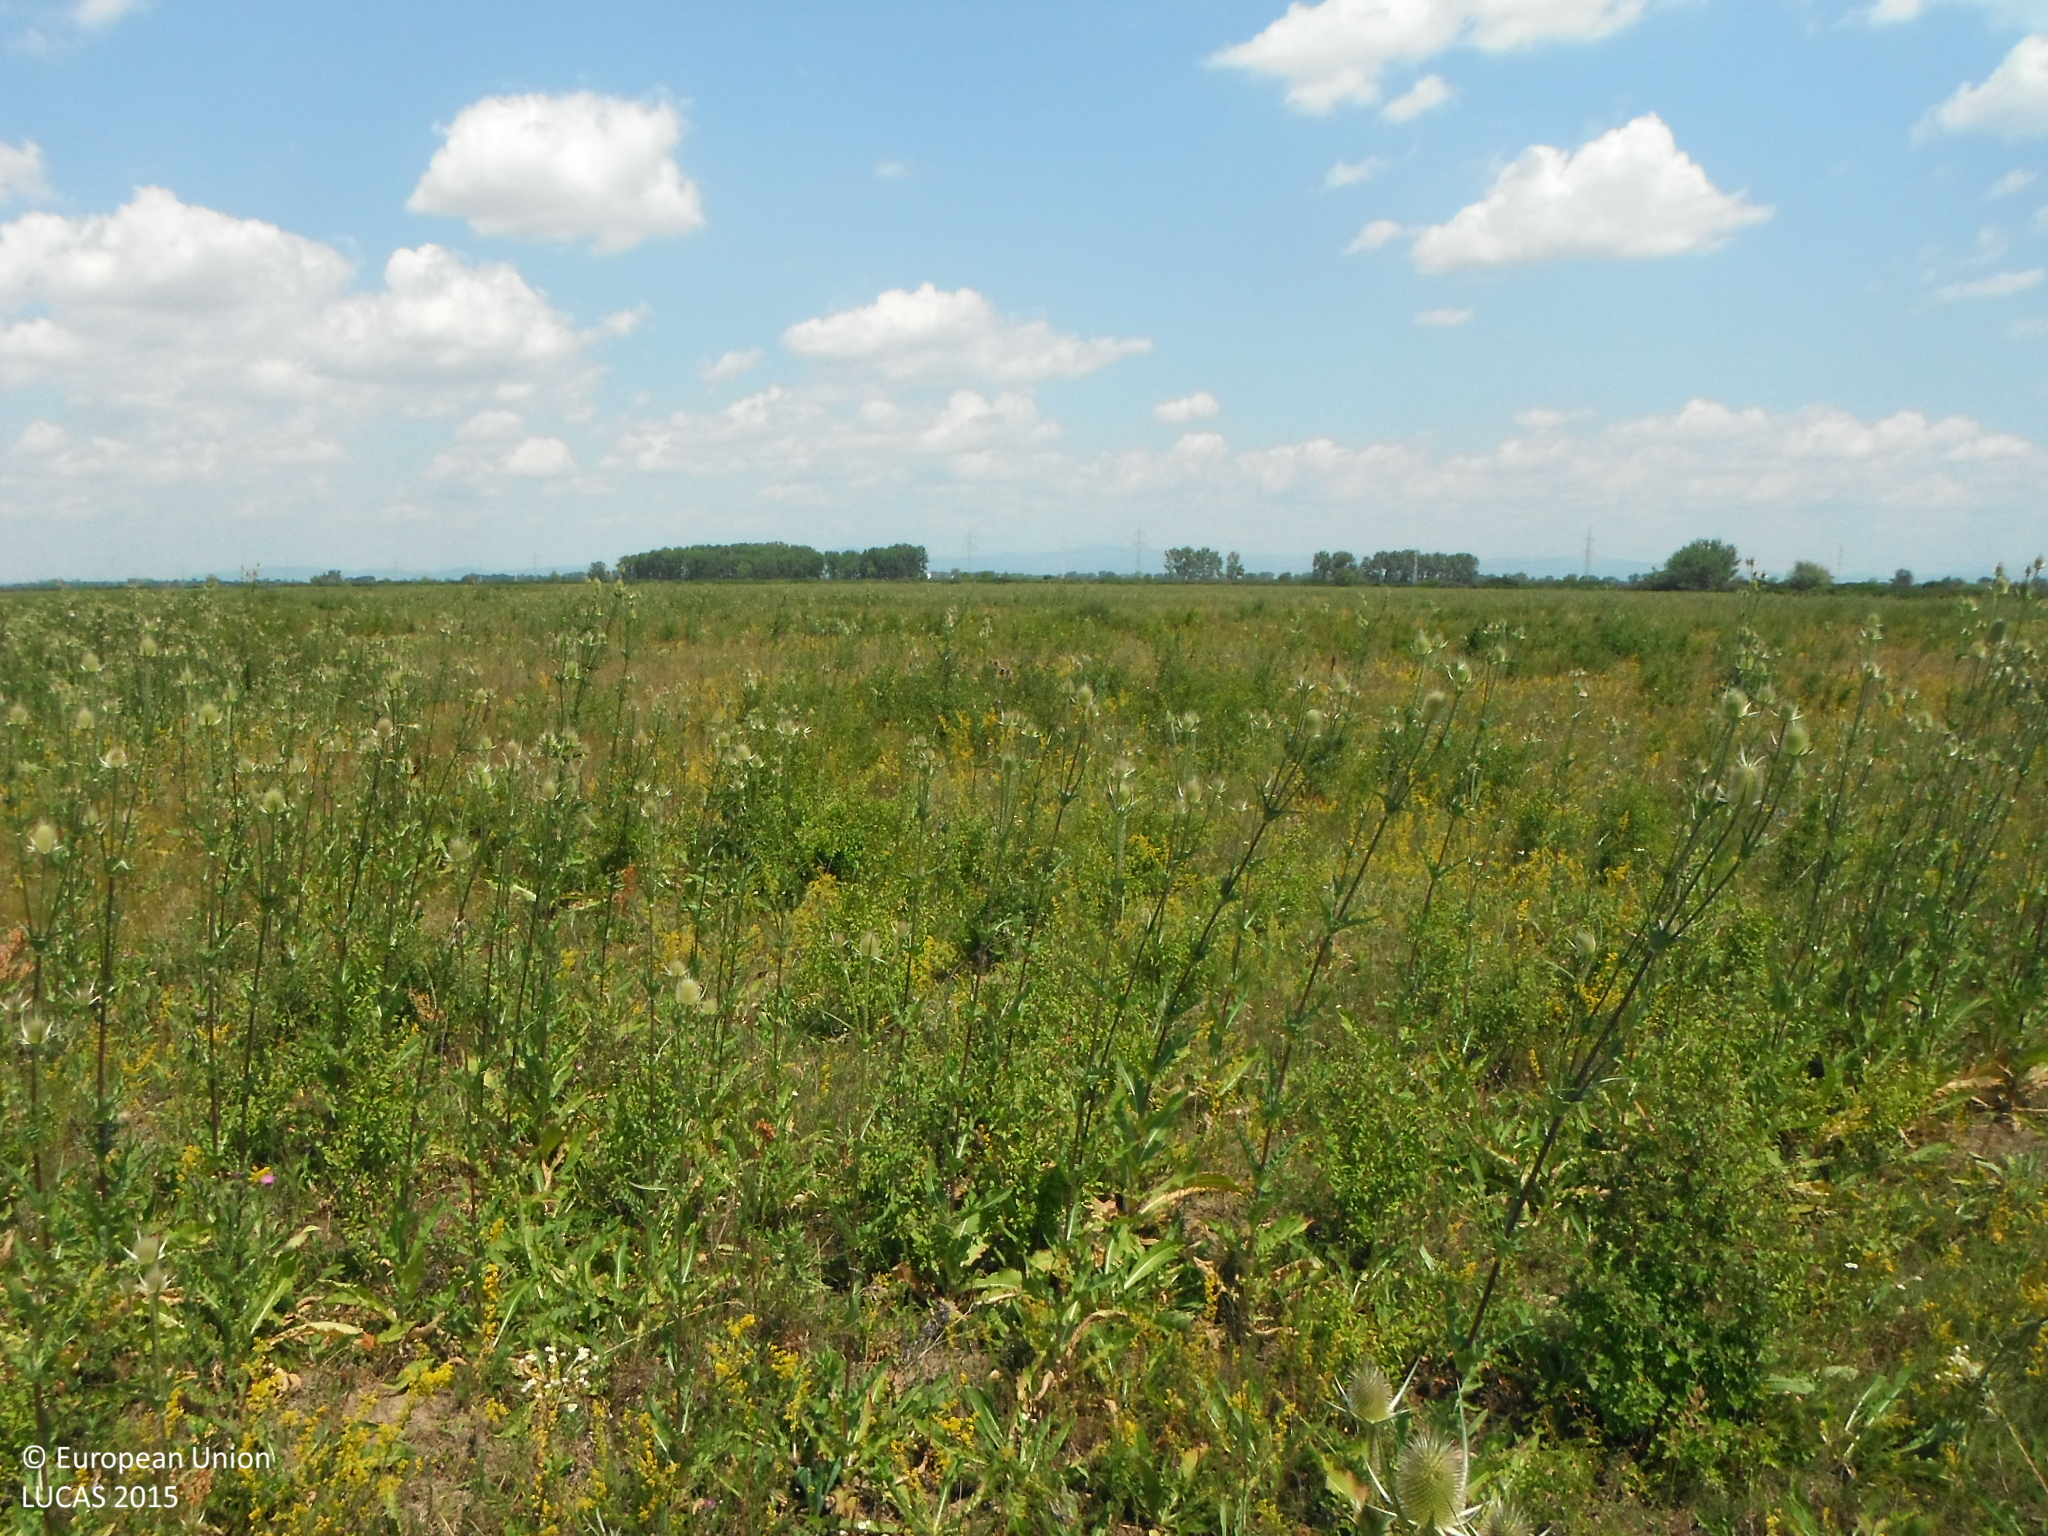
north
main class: Grassland
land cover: Spontaneously vegetated surfaces
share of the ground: > 75 %
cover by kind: herbaceous plants 100 %
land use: Agriculture (excluding fallow land and kitchen gardens)
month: July
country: SK
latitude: 48.5781
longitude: 21.8858
